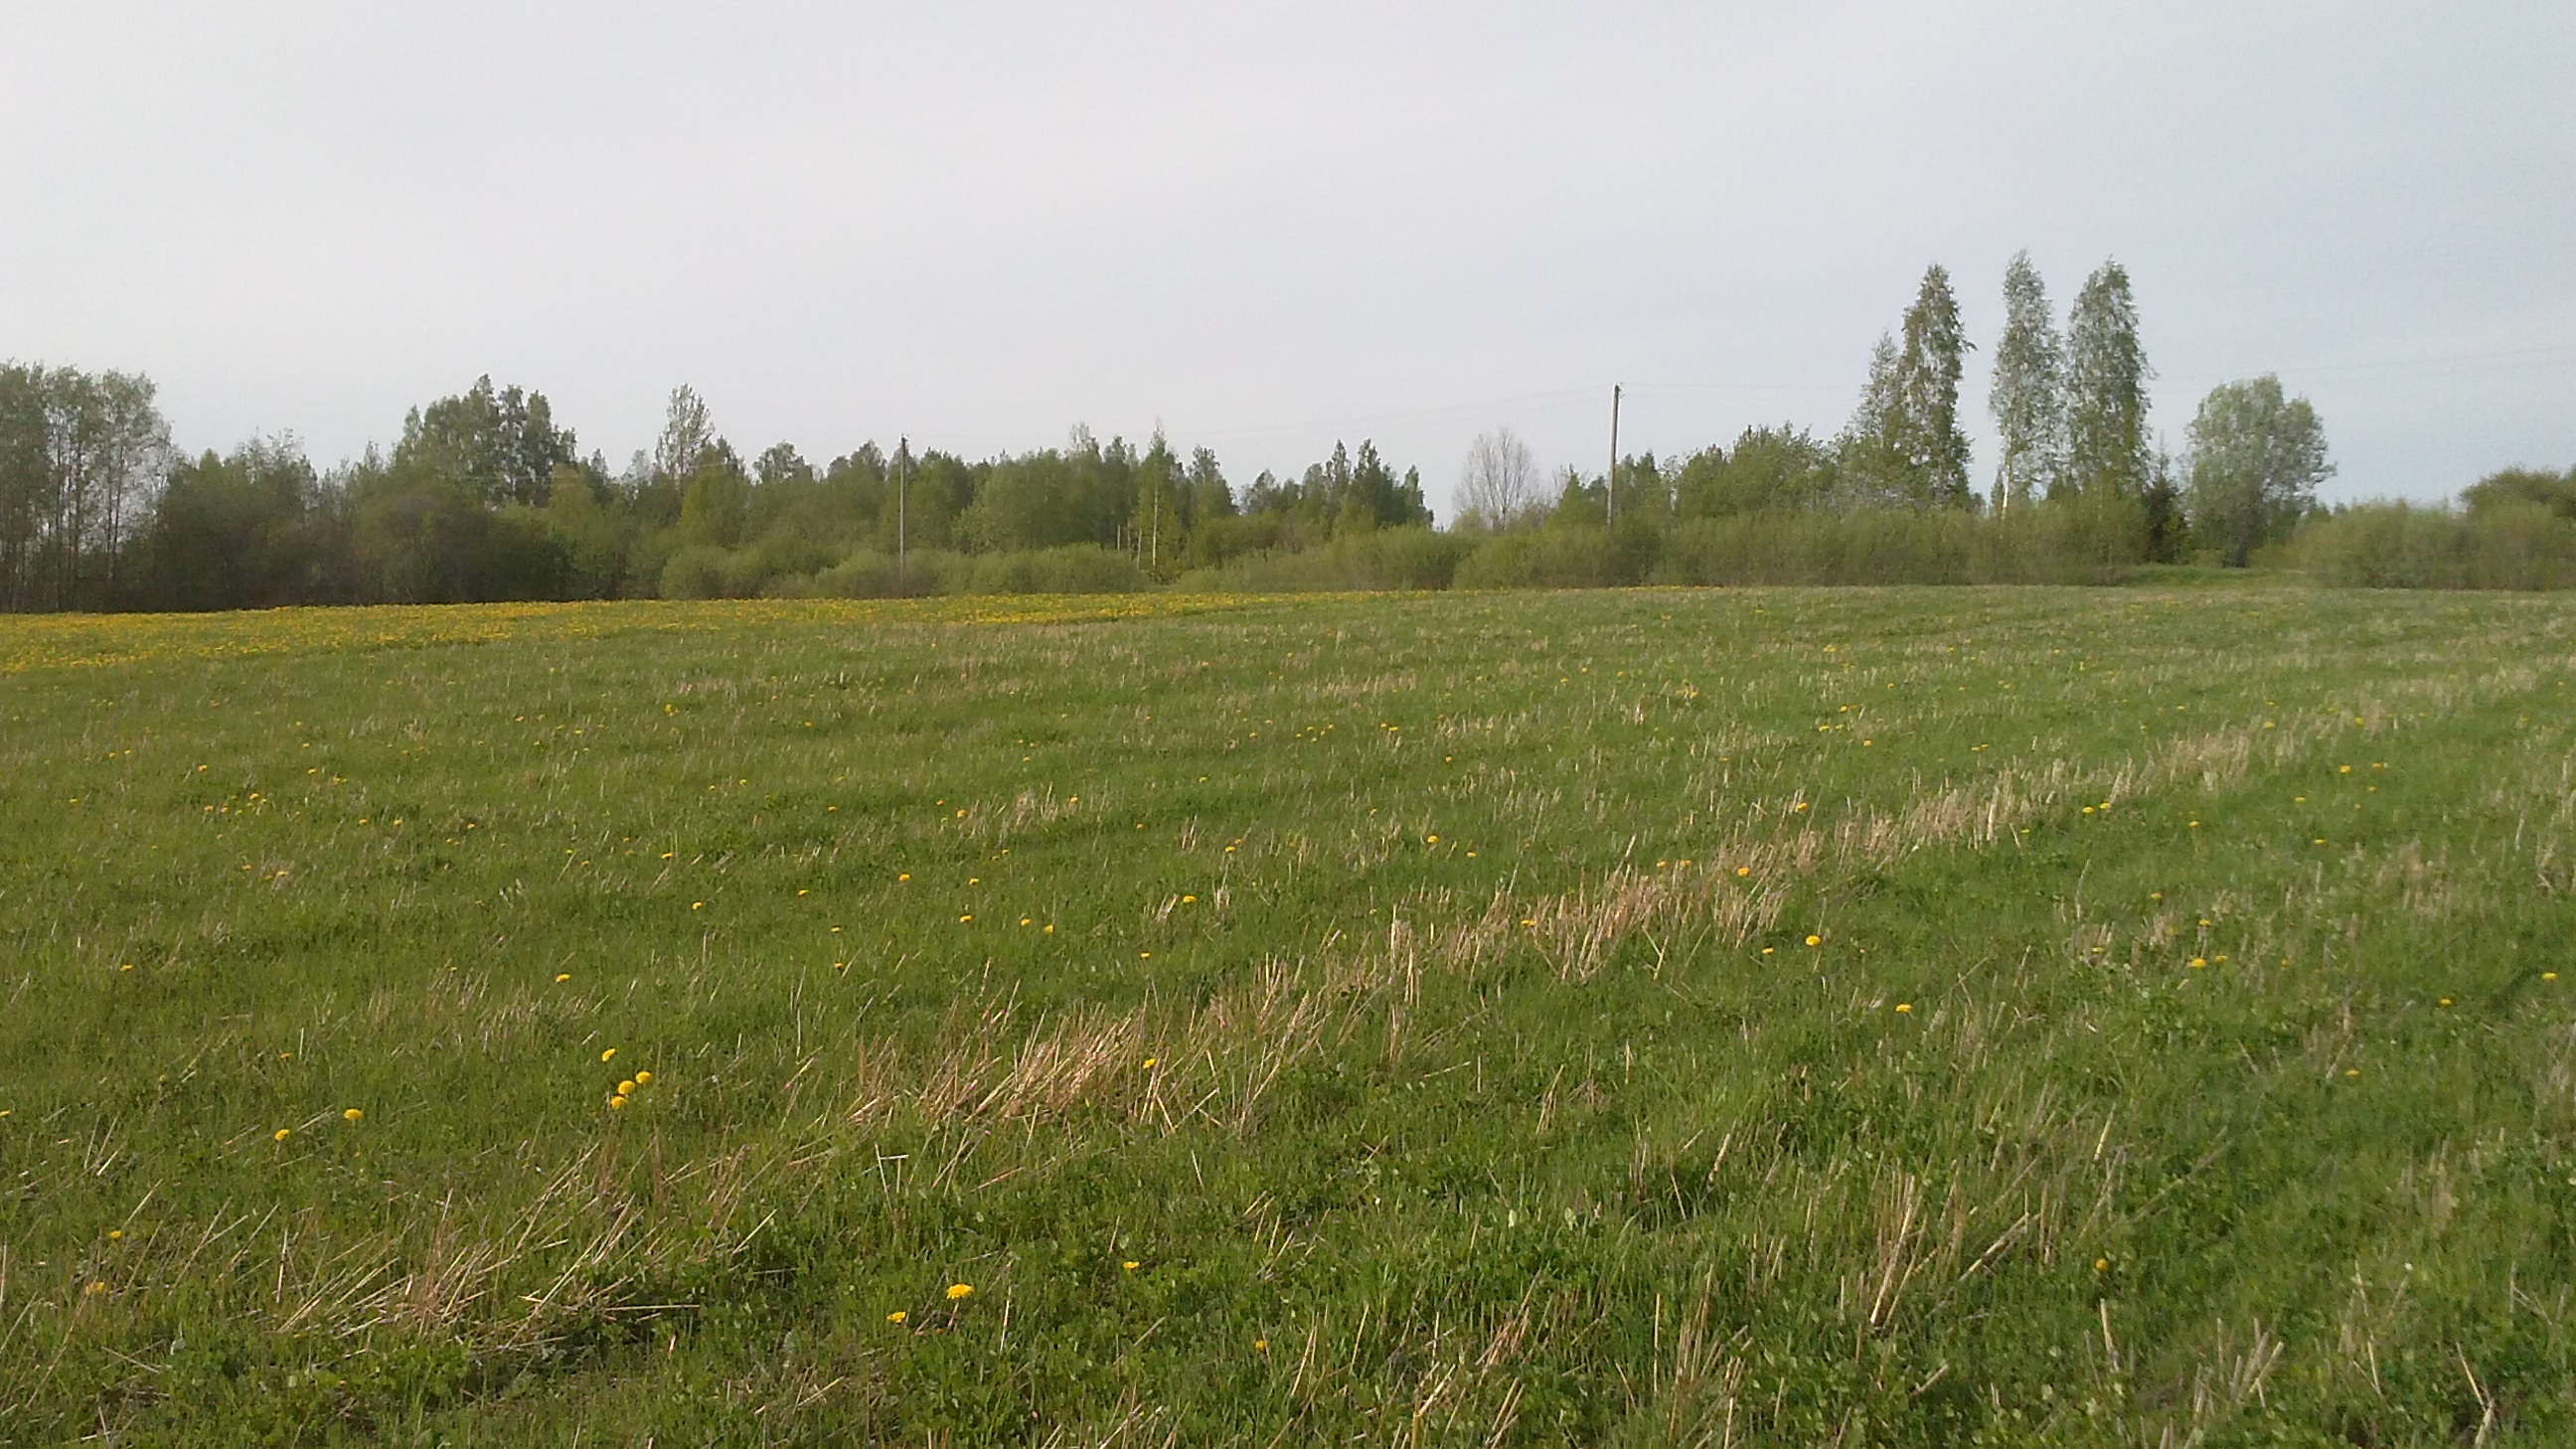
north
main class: Grassland
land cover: Grassland without tree/shrub cover
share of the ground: > 75 %
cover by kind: herbaceous plants 100 %
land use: Agriculture (excluding fallow land and kitchen gardens)
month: May
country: LV
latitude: 56.0103
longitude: 27.5868
